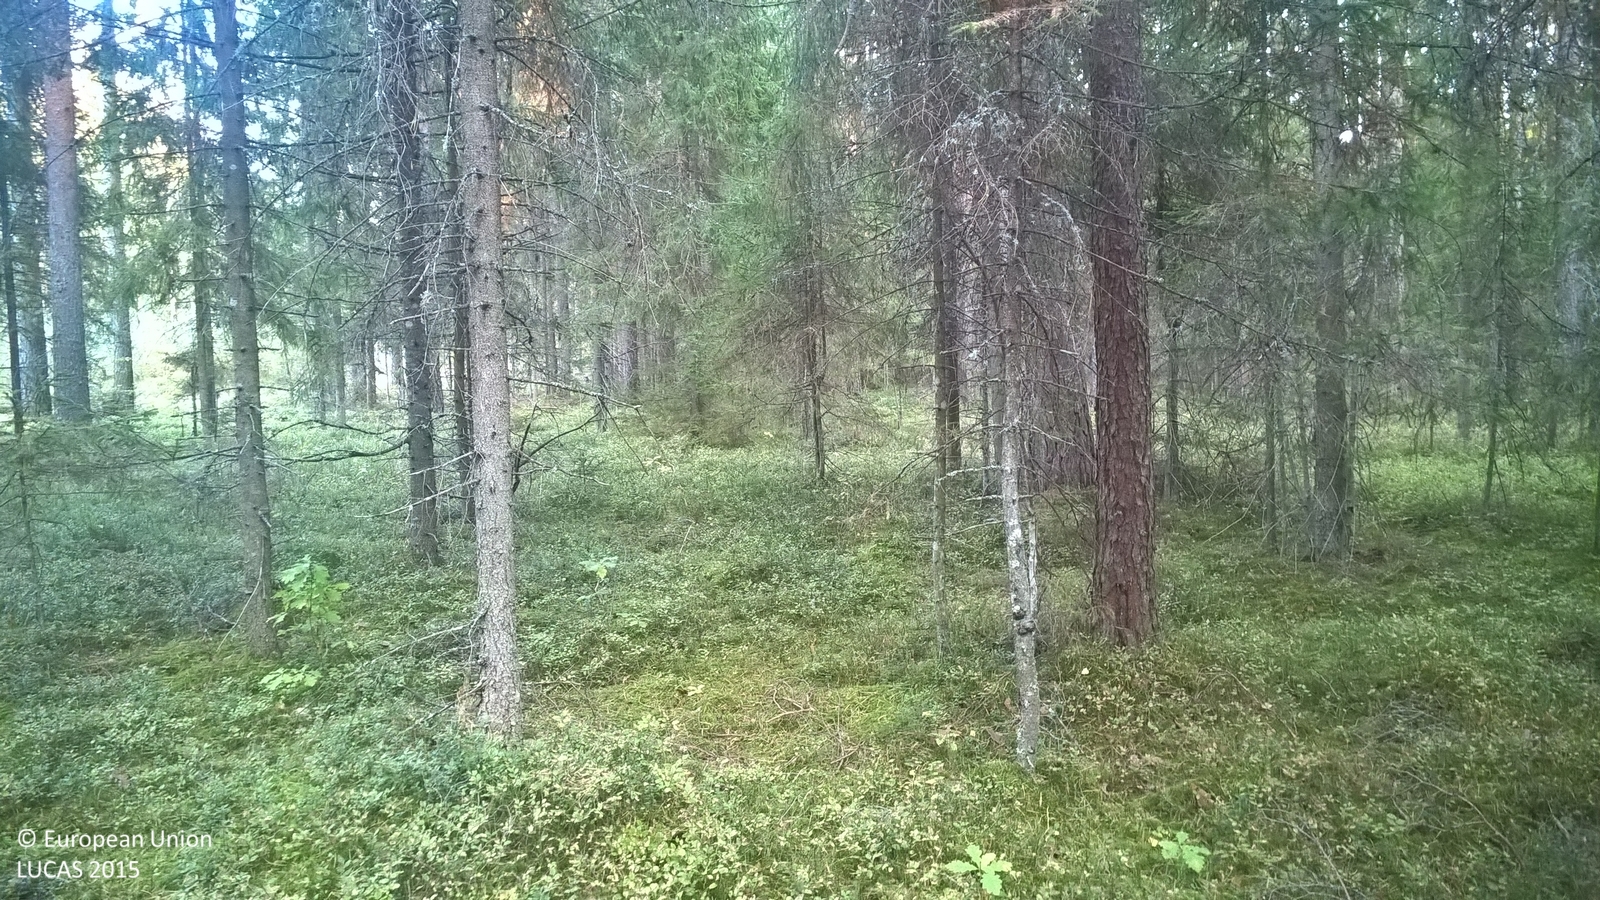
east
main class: Woodland
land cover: Other coniferous woodland
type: hemiboreal forest and nemoral coniferous forest and mixed broadleaved-coniferous forest
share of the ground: > 75 %
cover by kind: coniferous forest trees 80 %, lichens and mosses 20 %
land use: Forestry
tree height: > 5 m
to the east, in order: Other coniferous woodland; Paved roads, cycling and walking lanes; Grass margins; Paved roads, cycling and walking lanes; Pine dominated coniferous woodland; Tracks; Grassland with sparse tree/shrub cover; Tracks; Other coniferous woodland
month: September
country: LV
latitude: 57.6395
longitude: 25.6808
